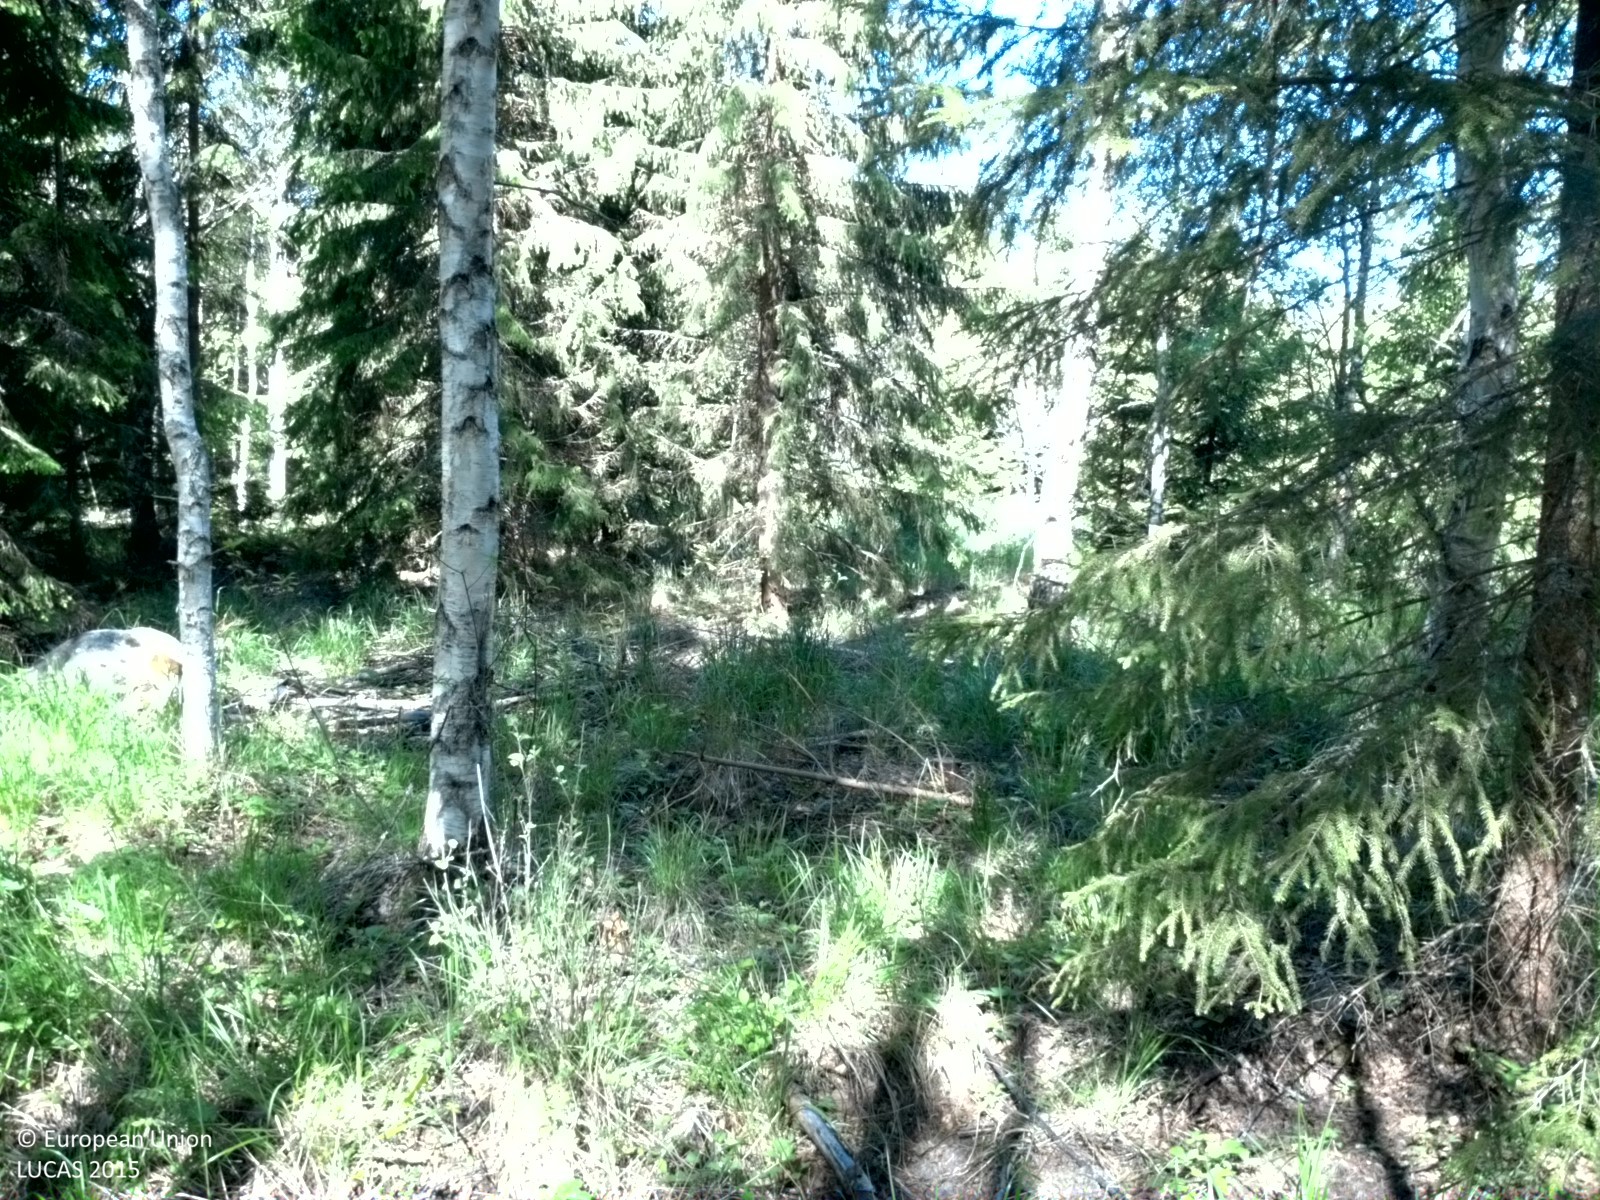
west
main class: Woodland
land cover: Pine dominated mixed woodland
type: boreal forest
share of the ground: 50 - 75 %
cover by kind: coniferous forest trees 45 %, broadleaved forest trees 20 %, herbaceous plants 20 %, shrubs 10 %
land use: Forestry
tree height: > 5 m
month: June
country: SE
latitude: 60.2312
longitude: 17.5579
